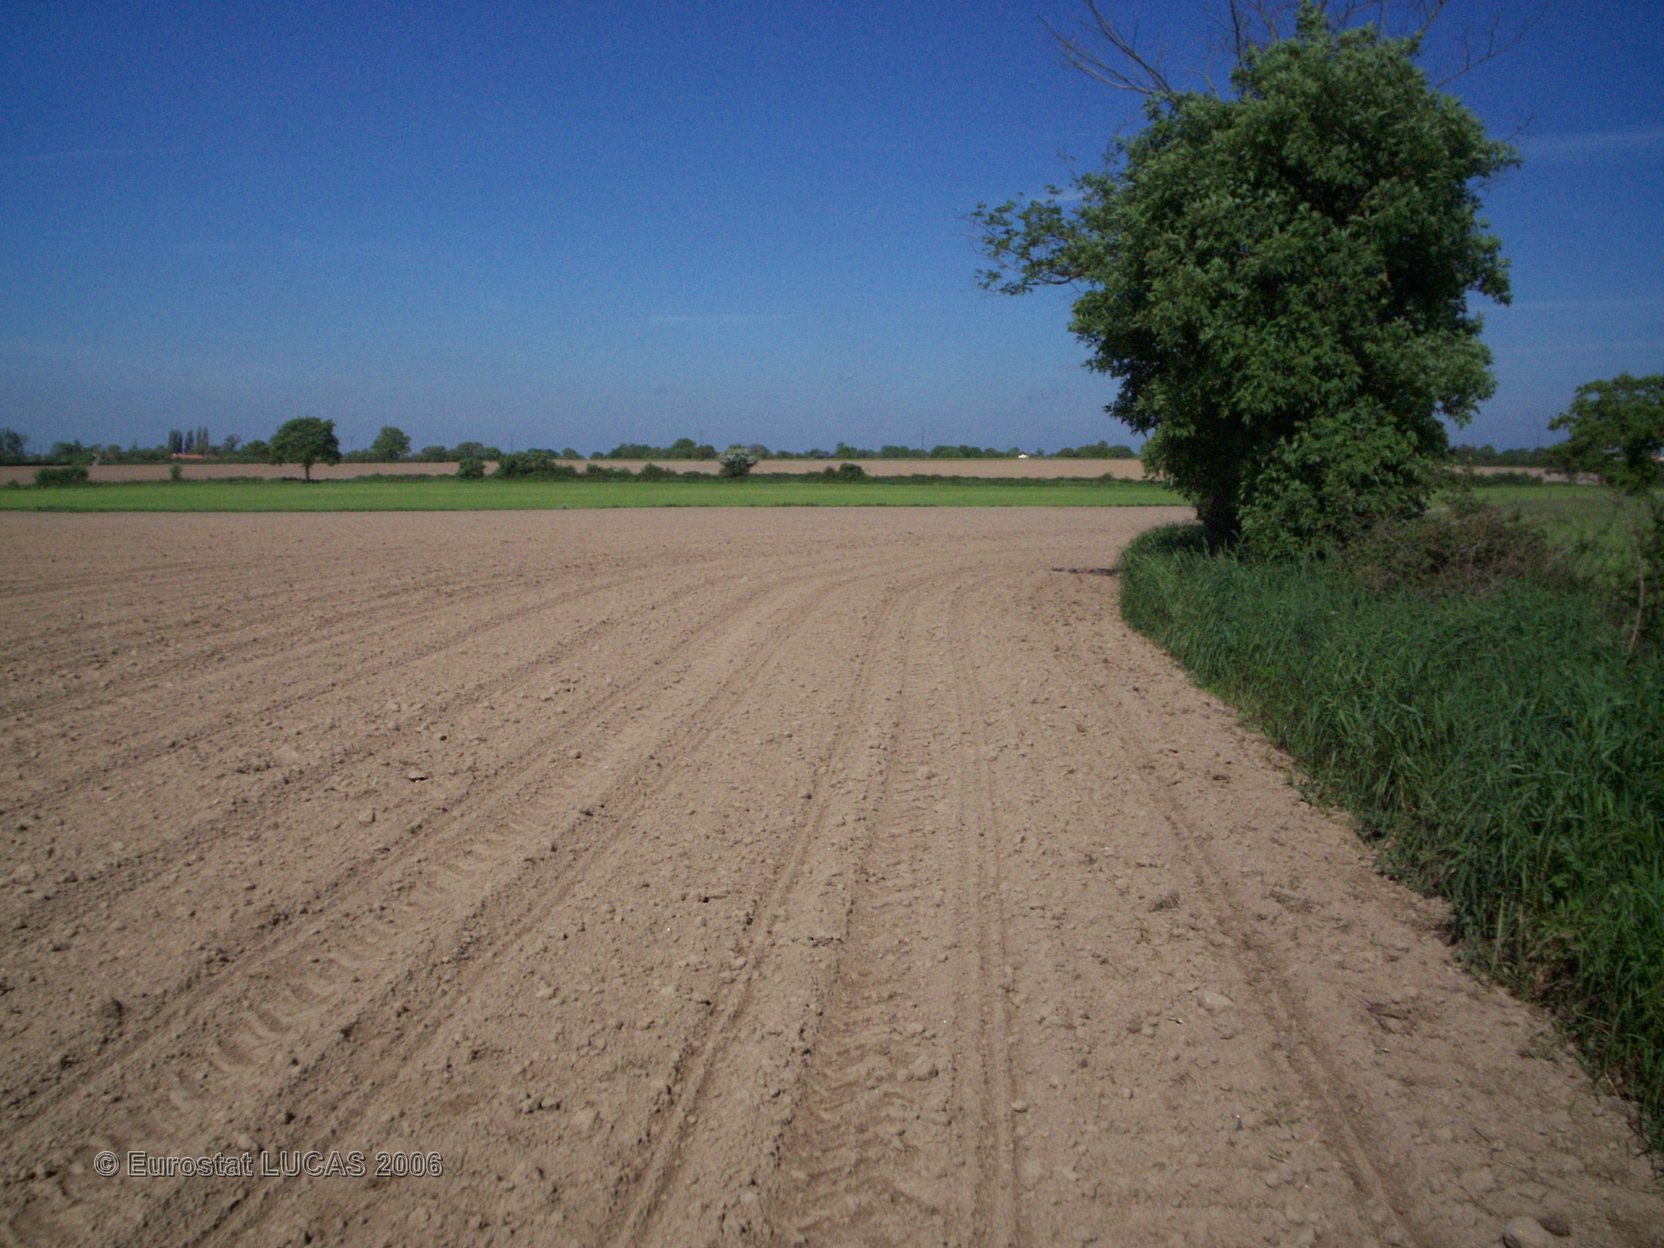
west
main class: Cropland
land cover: Maize
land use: Agriculture (excluding fallow land and kitchen gardens)
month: May
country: FR
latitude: 47.0155
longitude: -1.0190
